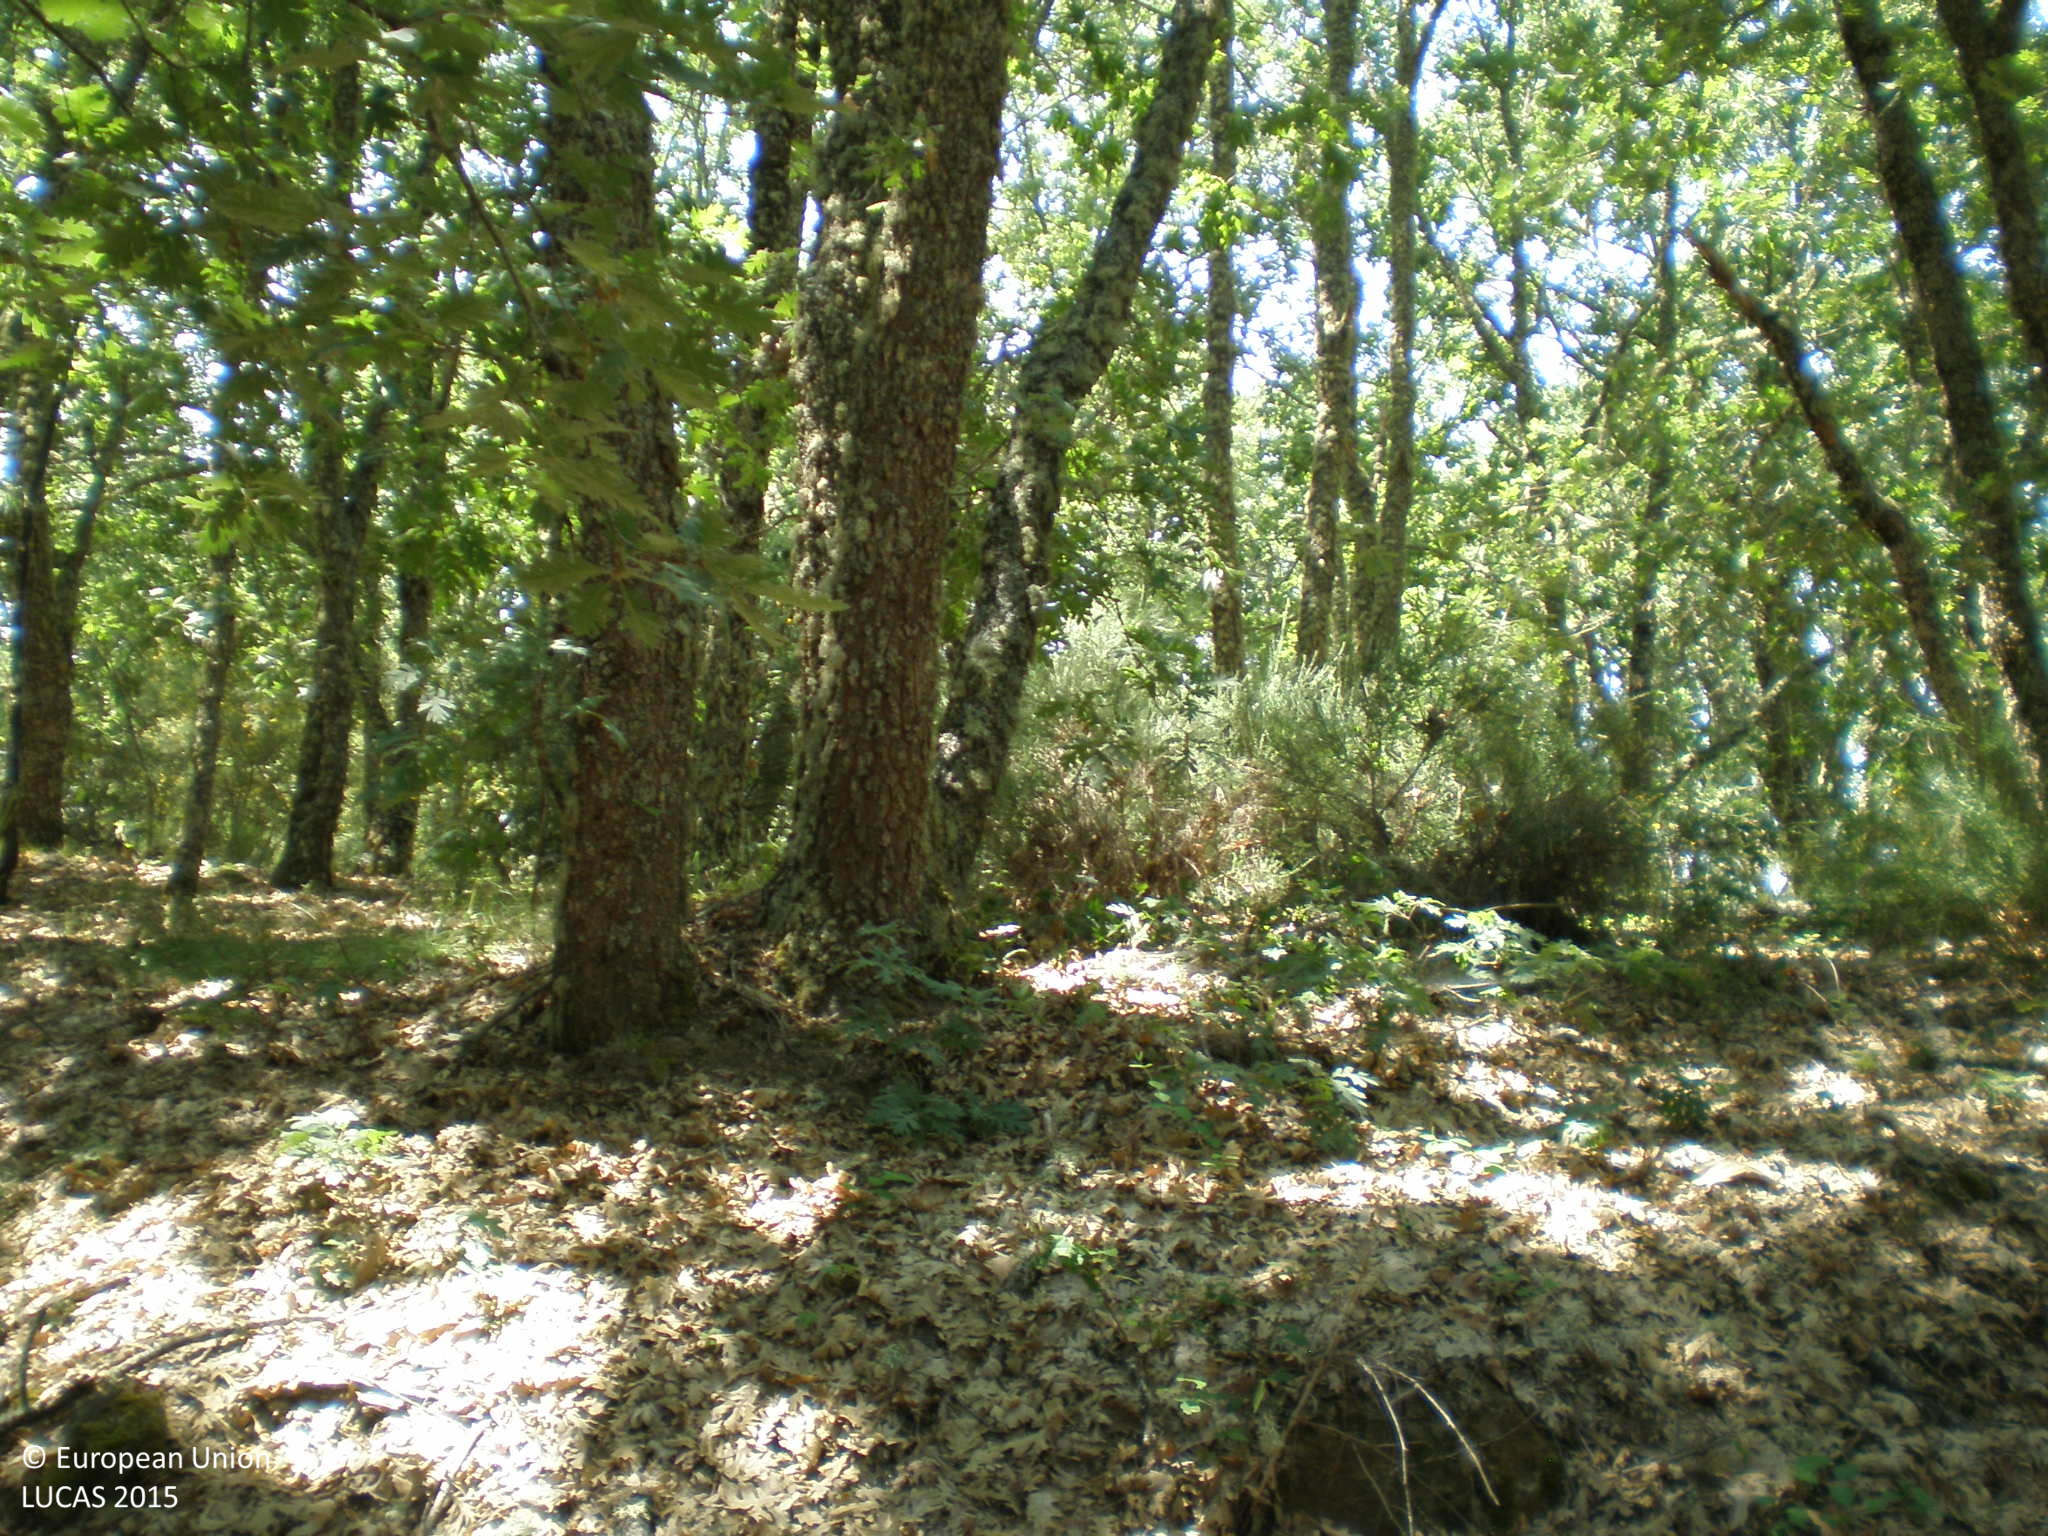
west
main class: Woodland
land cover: Broadleaved woodland
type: thermophilous deciduous forest
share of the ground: > 75 %
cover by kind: broadleaved forest trees 100 %
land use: Forestry
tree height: > 5 m
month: June
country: ES
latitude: 40.3217
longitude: -5.5652
